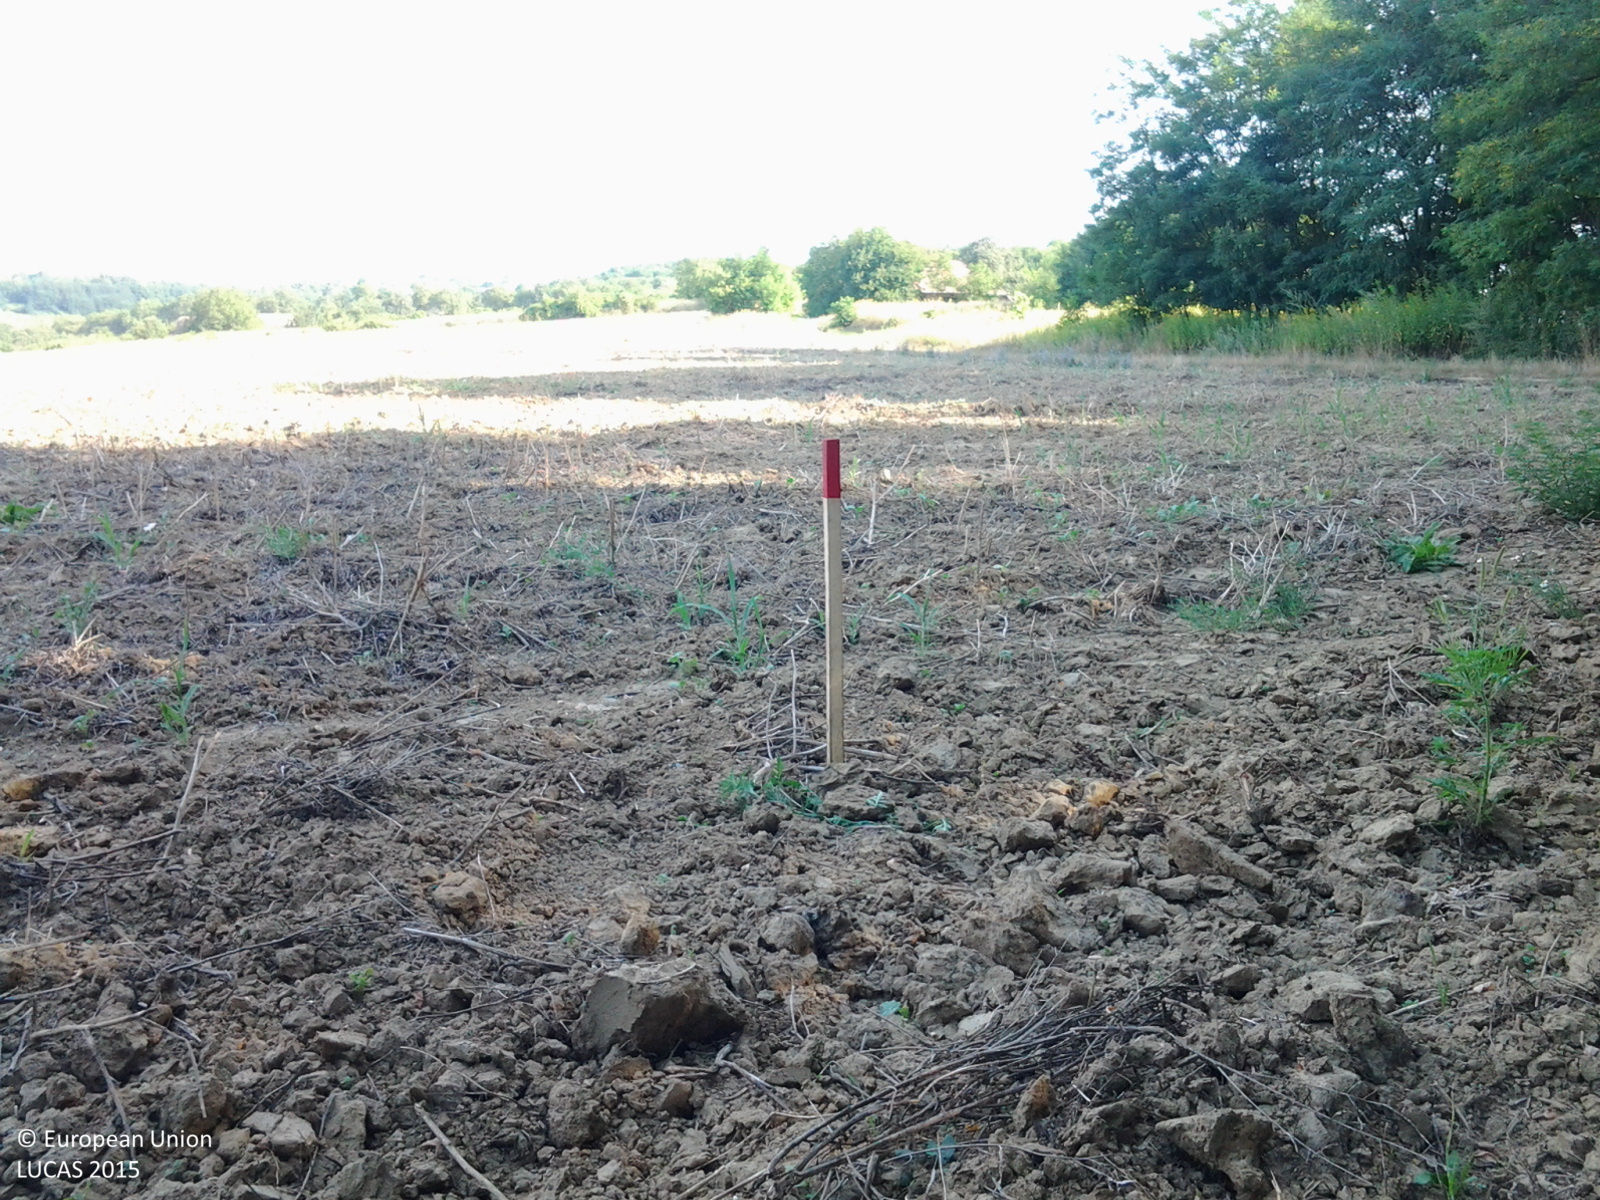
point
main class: Cropland
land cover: Rape and turnip rape
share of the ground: < 10 %
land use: Agriculture (excluding fallow land and kitchen gardens)
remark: Harvested field
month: August
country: HU
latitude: 46.6413
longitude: 17.0712
